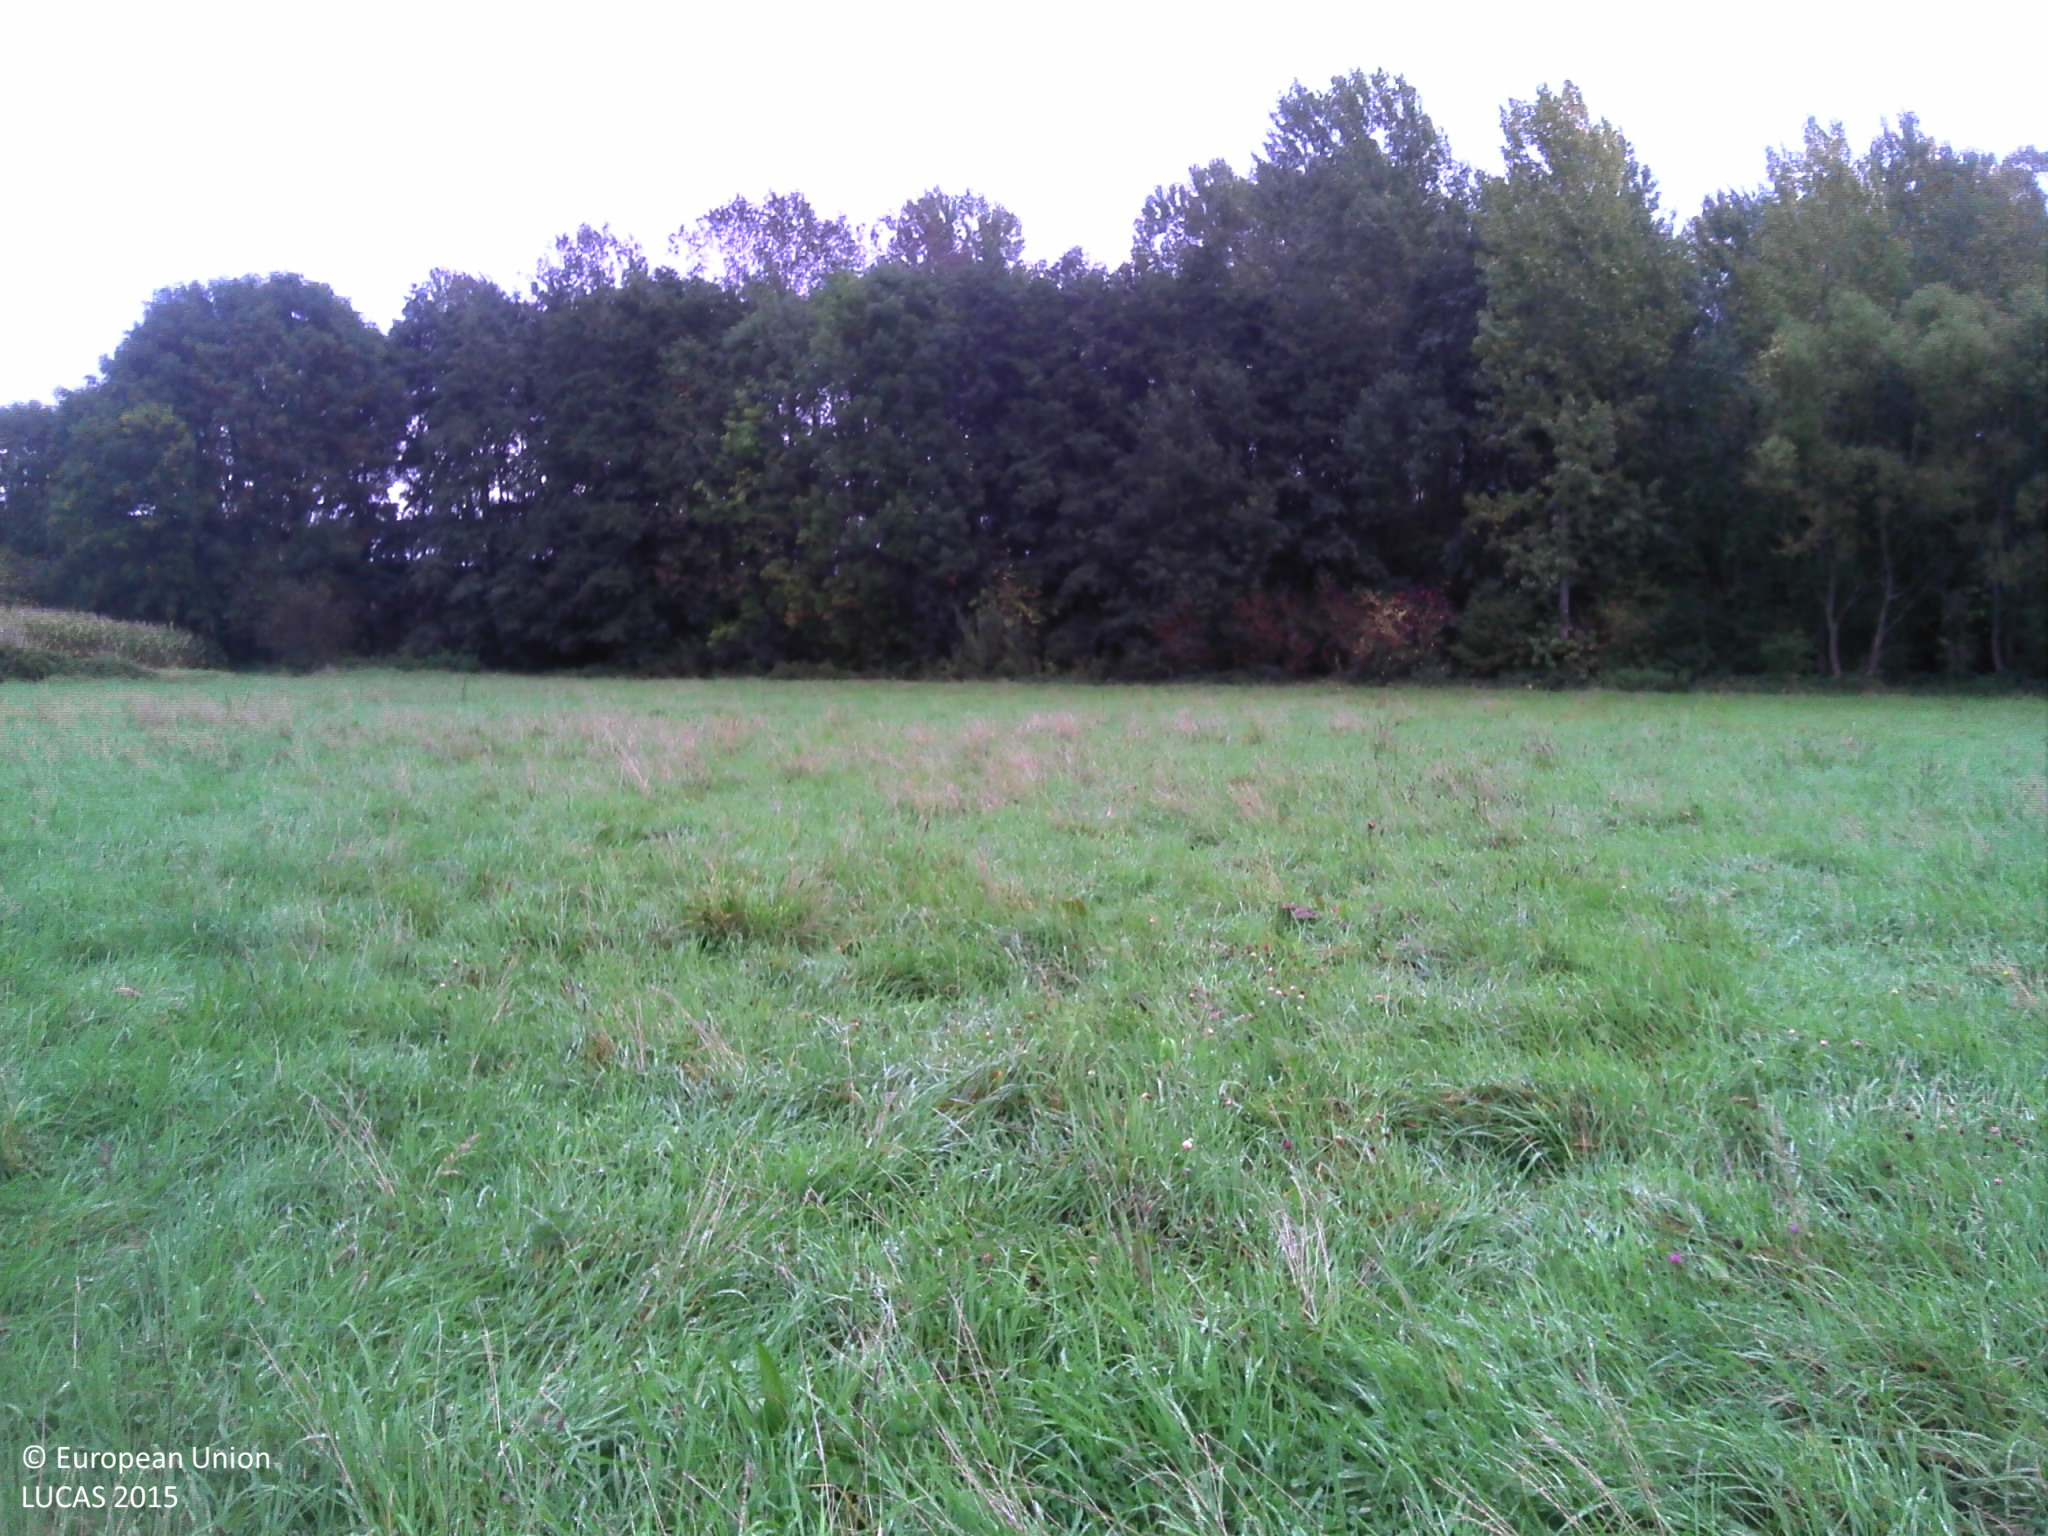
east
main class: Grassland
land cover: Grassland without tree/shrub cover
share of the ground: > 75 %
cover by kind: herbaceous plants 100 %
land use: Agriculture (excluding fallow land and kitchen gardens)
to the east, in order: Grassland without tree/shrub cover; Ditches and canals; Broadleaved woodland; Grassland without tree/shrub cover; Paved roads, cycling and walking lanes; Electric lines; Grassland without tree/shrub cover; Artificial constructions in urban areas
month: October
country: BE
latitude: 51.0549
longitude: 4.7606
